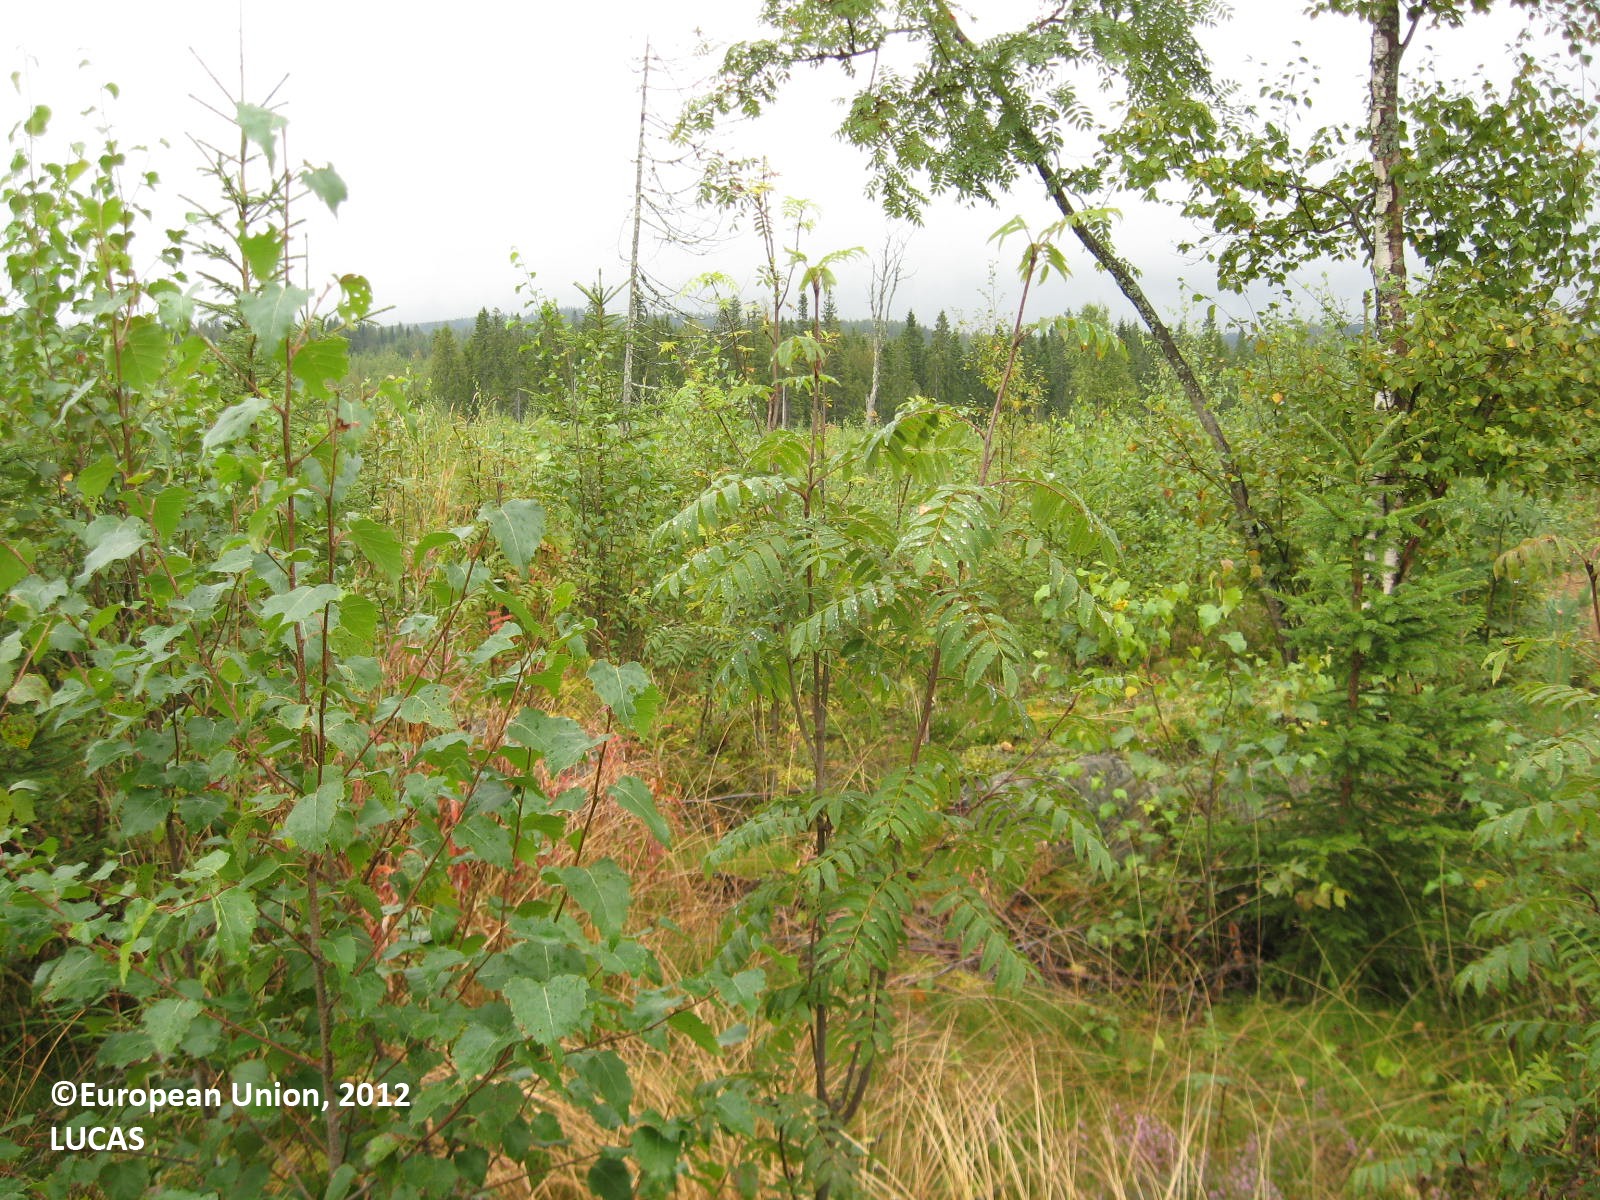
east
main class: Woodland
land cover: Other mixed woodland
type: boreal forest
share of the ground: > 75 %
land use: Forestry
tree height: < 5 m
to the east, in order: Other mixed woodland; Spruce dominated coniferous woodland; Ditches and canals; Spruce dominated coniferous woodland; Ditches and canals; Spruce dominated coniferous woodland
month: August
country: FI
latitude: 63.5769
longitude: 29.3763
